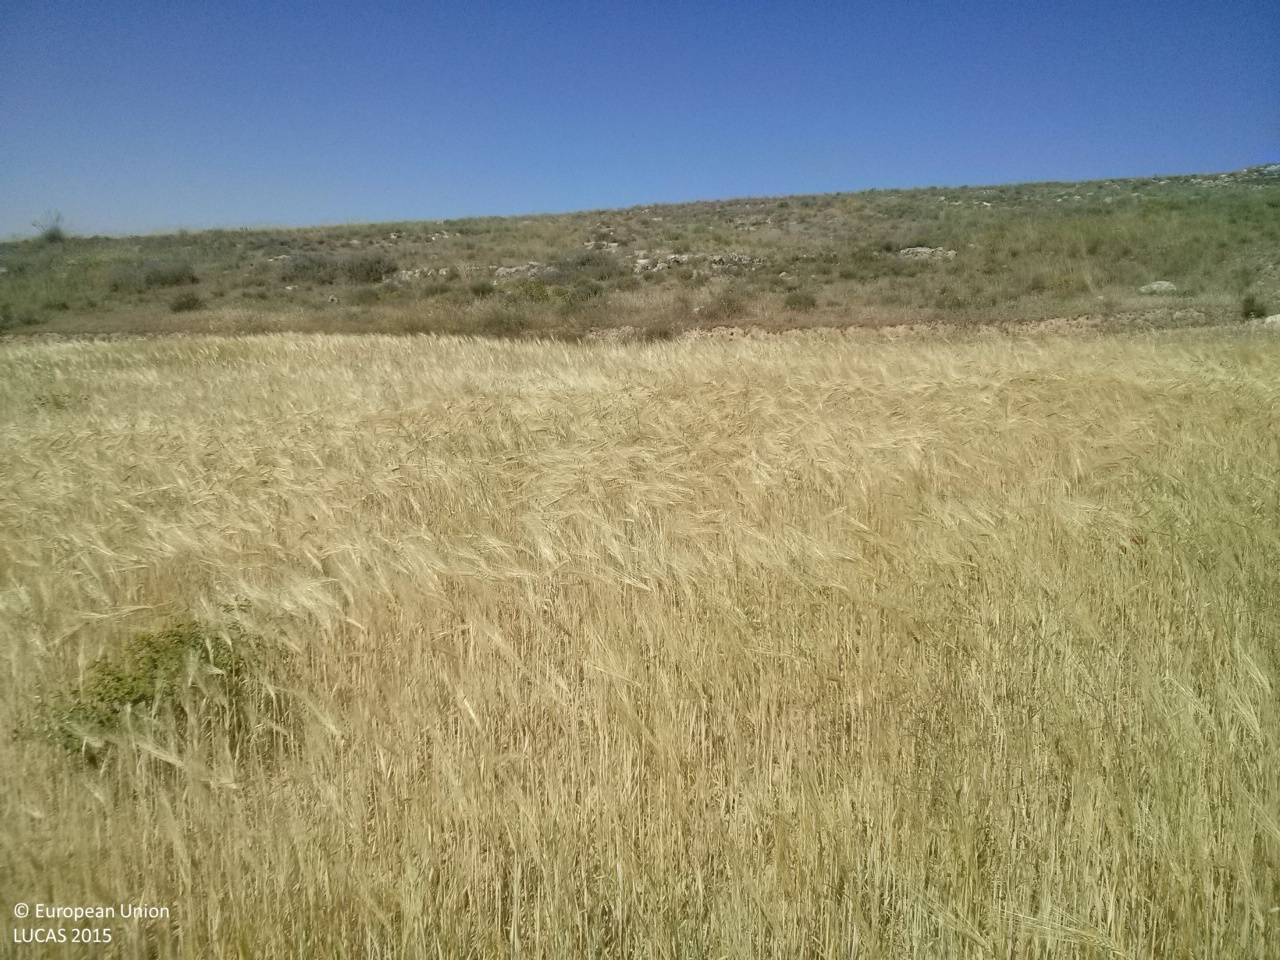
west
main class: Cropland
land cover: Barley
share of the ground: > 75 %
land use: Agriculture (excluding fallow land and kitchen gardens)
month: May
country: ES
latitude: 40.3285
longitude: -2.6054
